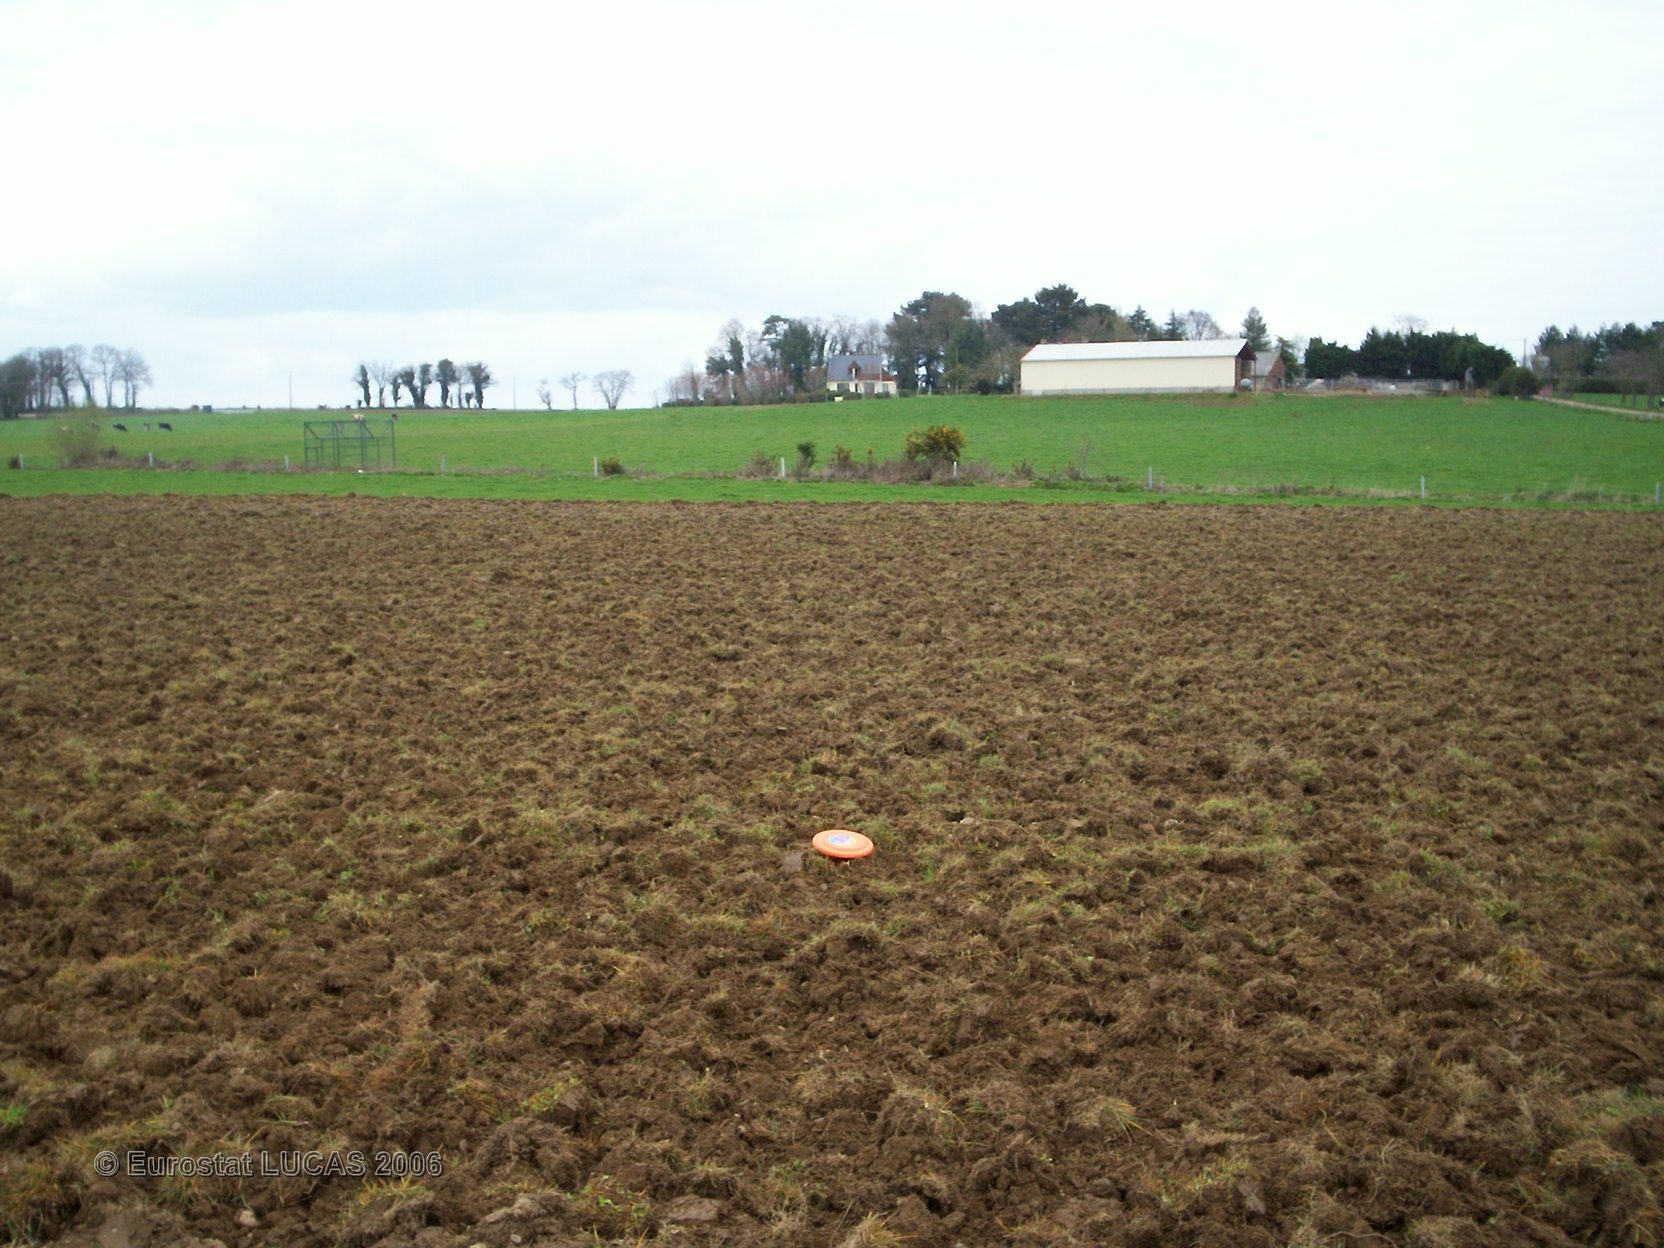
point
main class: Cropland
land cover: Dry pulses
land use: Agriculture (excluding fallow land and kitchen gardens)
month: May
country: FR
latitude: 48.0943
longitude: -2.9438
